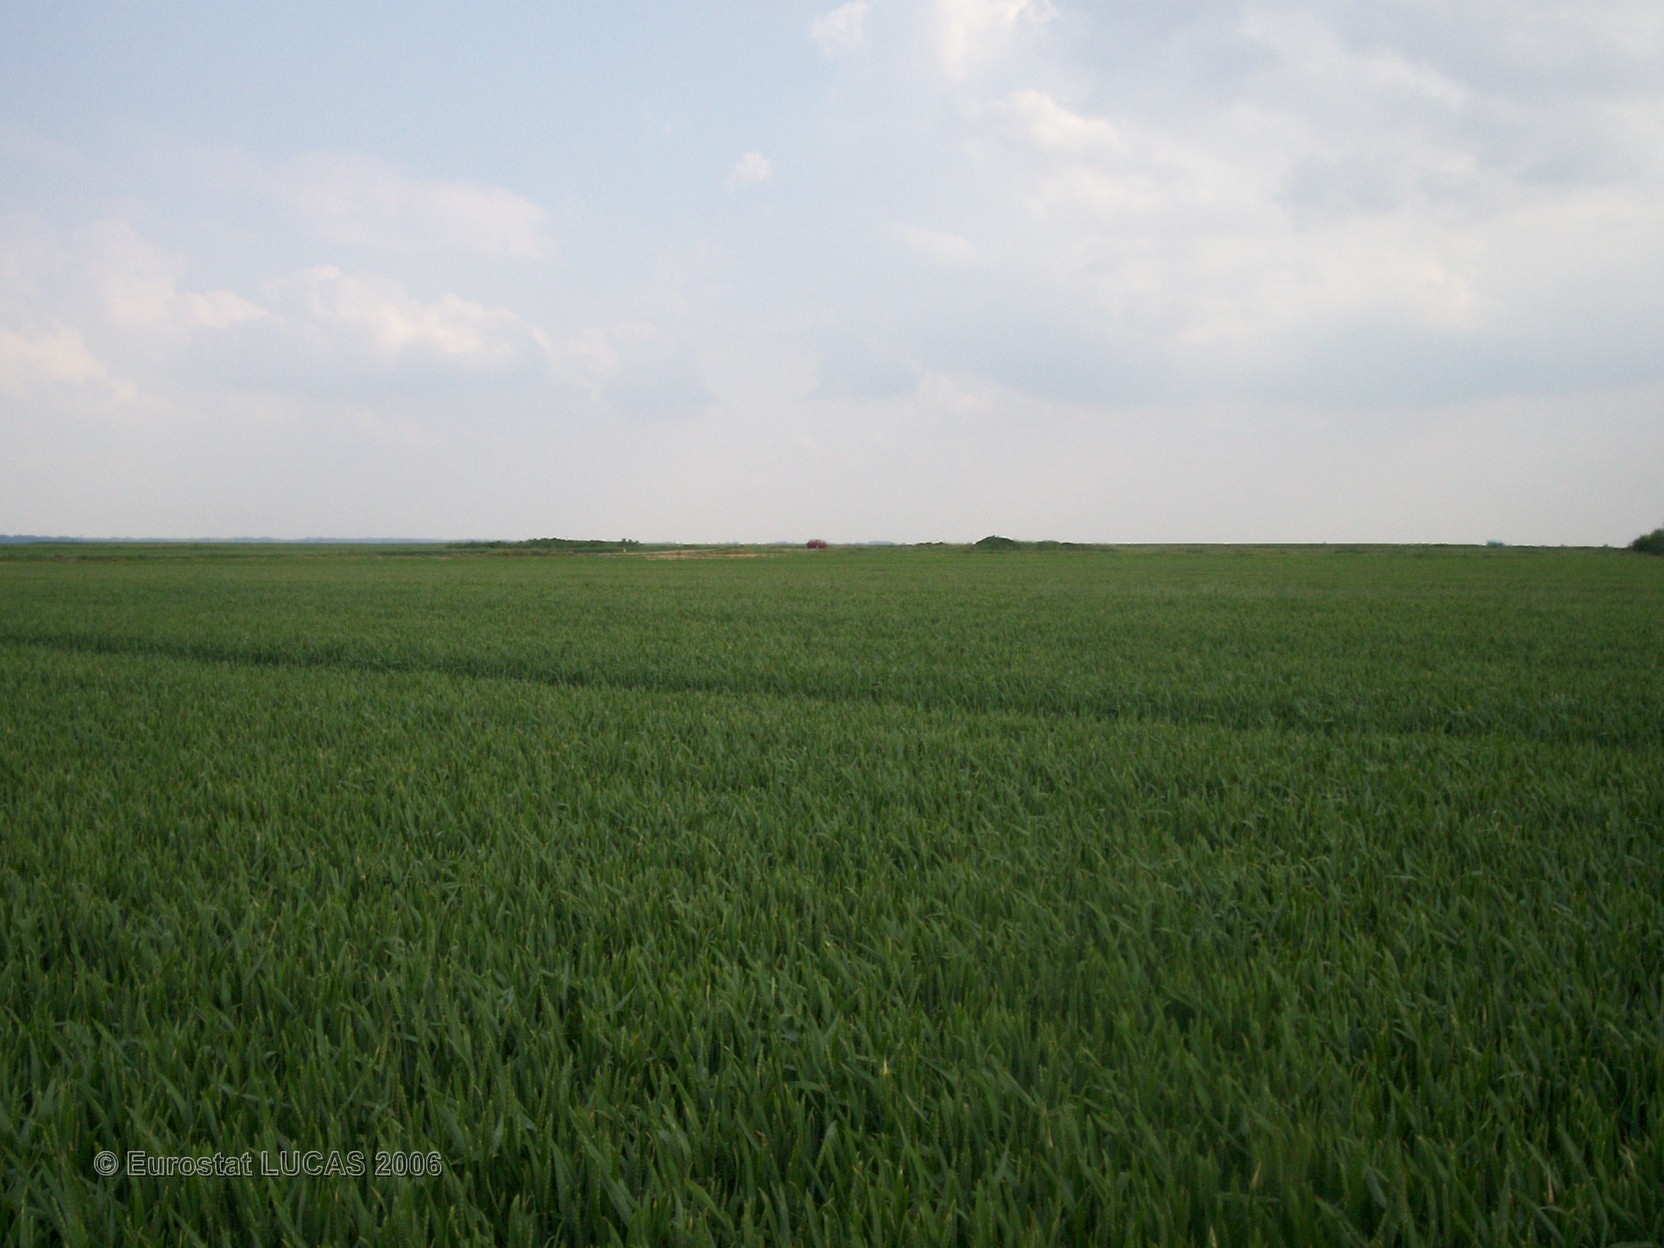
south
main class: Cropland
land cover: Common wheat
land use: Agriculture (excluding fallow land and kitchen gardens)
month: June
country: FR
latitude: 49.6568
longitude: 2.6329
